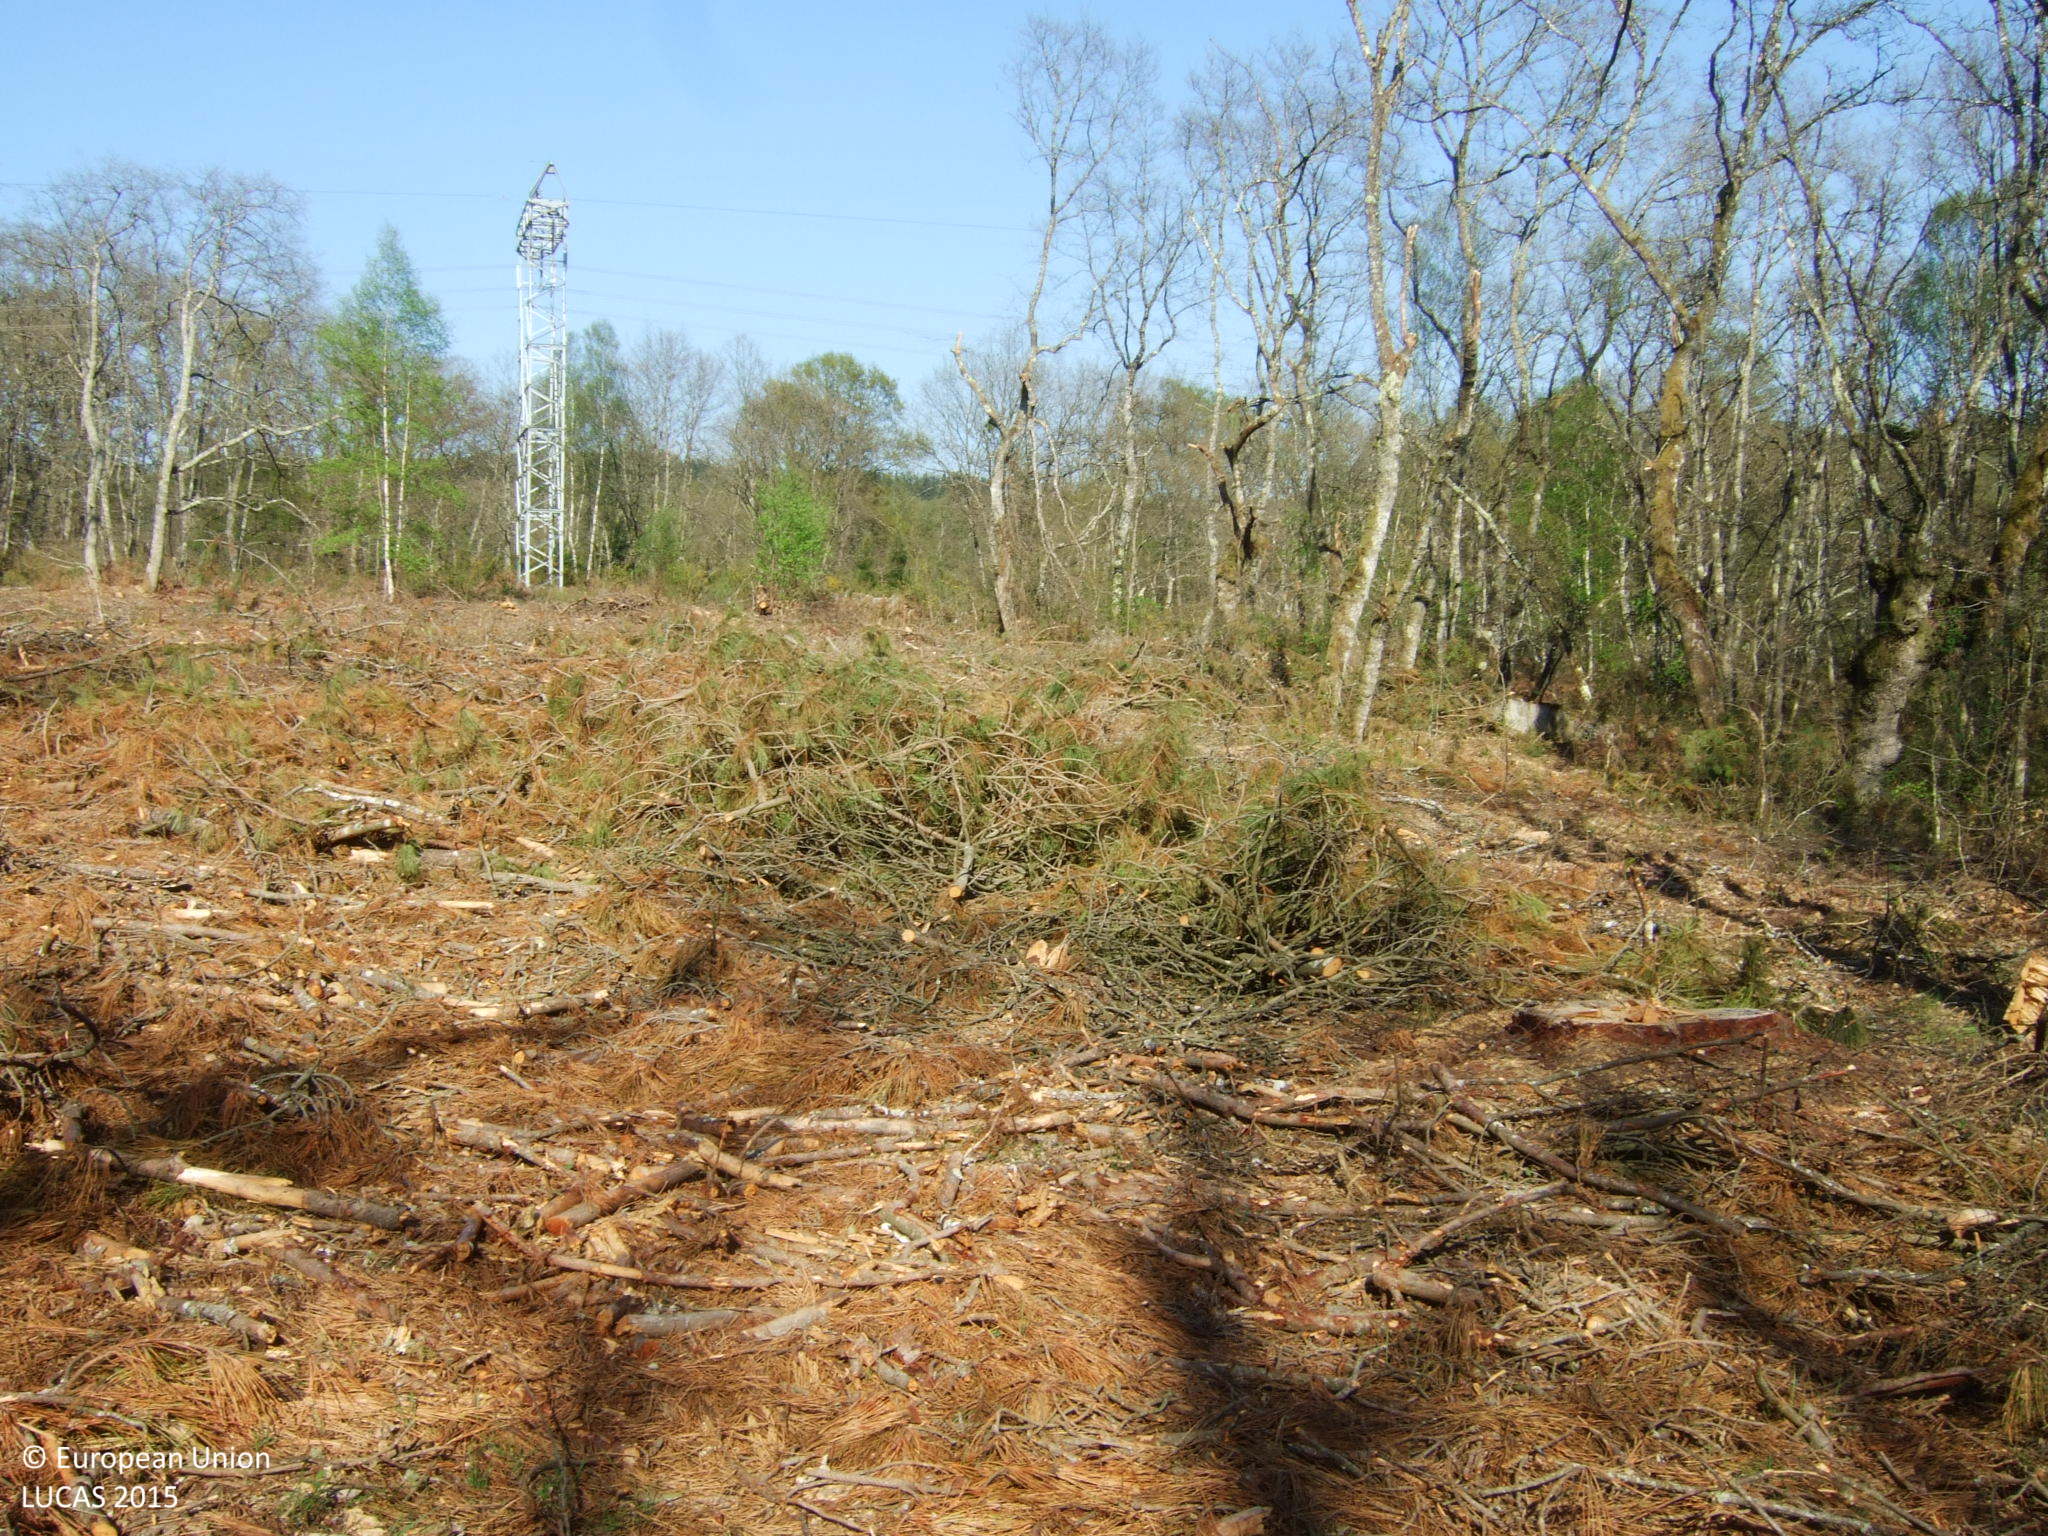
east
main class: Woodland
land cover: Broadleaved woodland
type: acidophilous oak and oak-birch forest
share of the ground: 10 - 25 %
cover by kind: unconsolidated bare surface 85 %, broadleaved forest trees 15 %
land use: Forestry
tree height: > 5 m
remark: Clear cut
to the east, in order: Broadleaved woodland; Other bare soil; Broadleaved woodland; Electric lines; Shrubland without tree cover; Broadleaved woodland; Shrubland with sparse tree cover; Groves; Electric lines; Pine dominated coniferous woodland
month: April
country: ES
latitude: 43.0488
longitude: -7.6226
